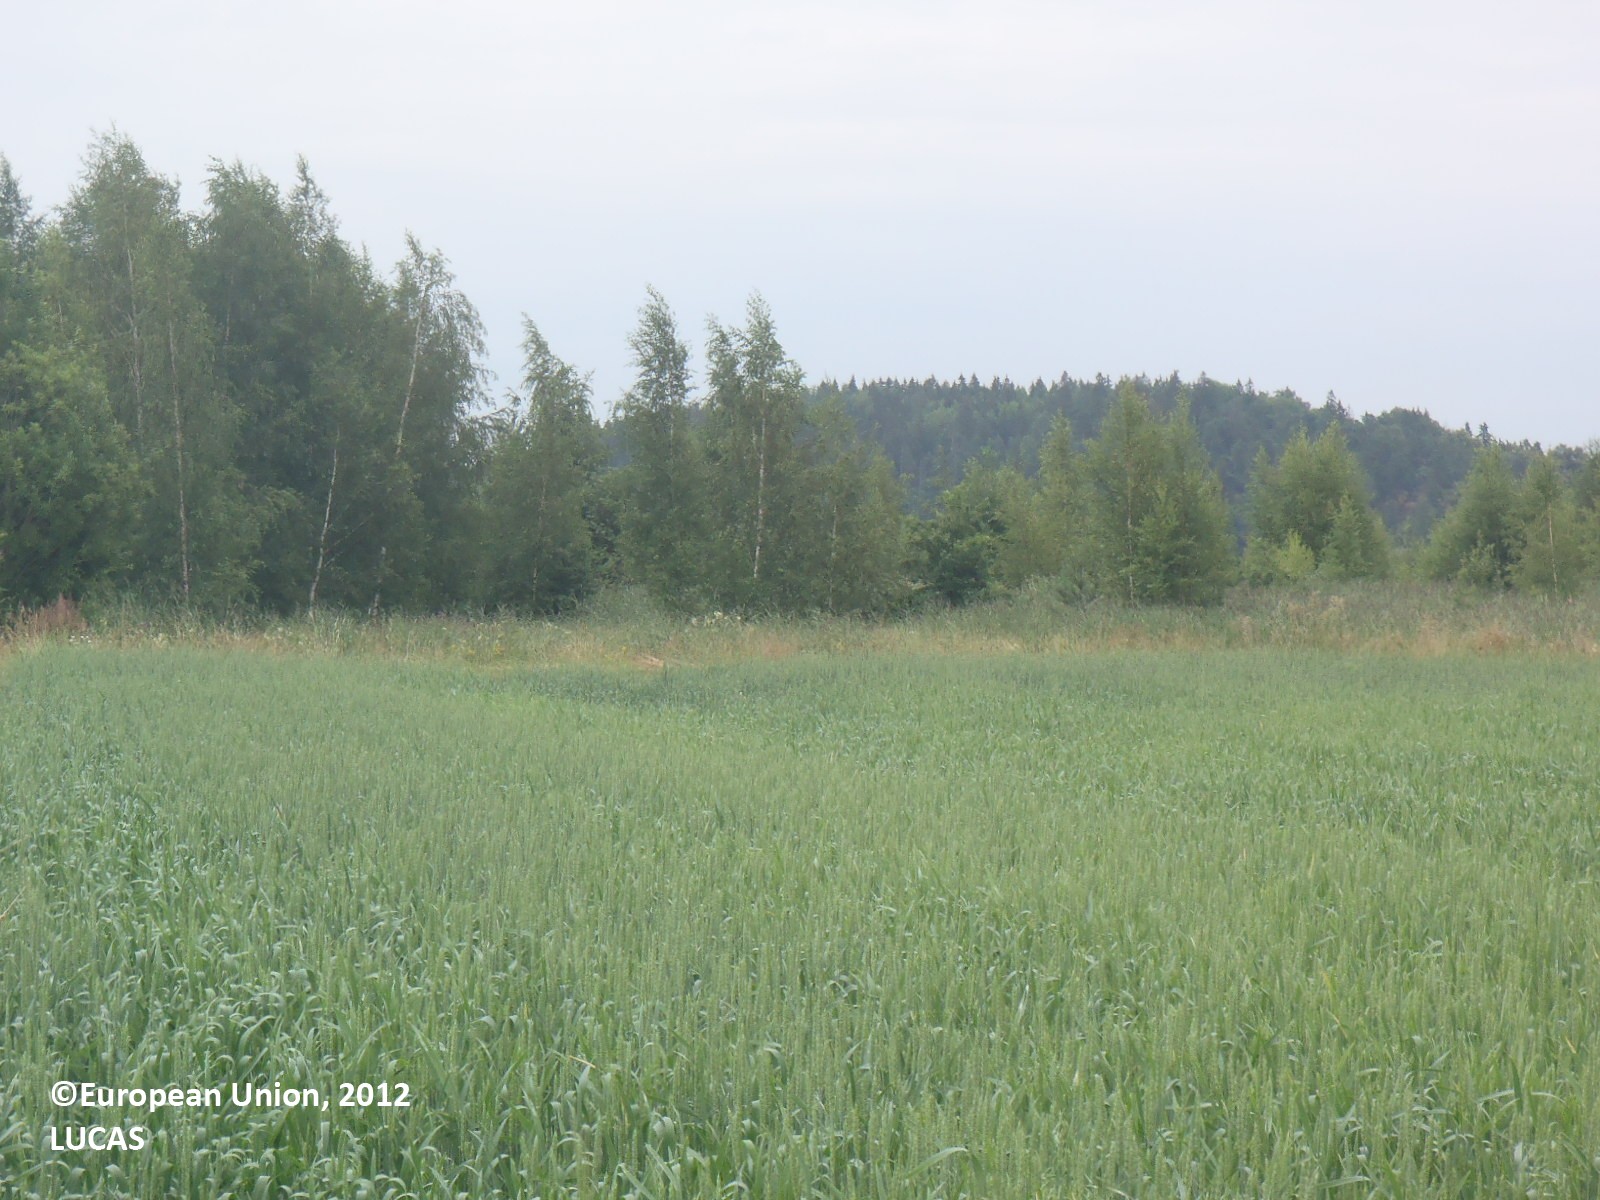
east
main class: Cropland
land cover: Common wheat
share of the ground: > 75 %
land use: Agriculture (excluding fallow land and kitchen gardens)
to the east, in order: Common wheat; Grassland without tree/shrub cover; Paved roads, cycling and walking lanes; Grass margins; Ditches and canals; Temporary grasslands; Ditches and canals; Inland marshes; Abandoned hedges; Inland marshes; Single bushes/trees; Inland marshes
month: July
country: FI
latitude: 60.4109
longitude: 22.2496
